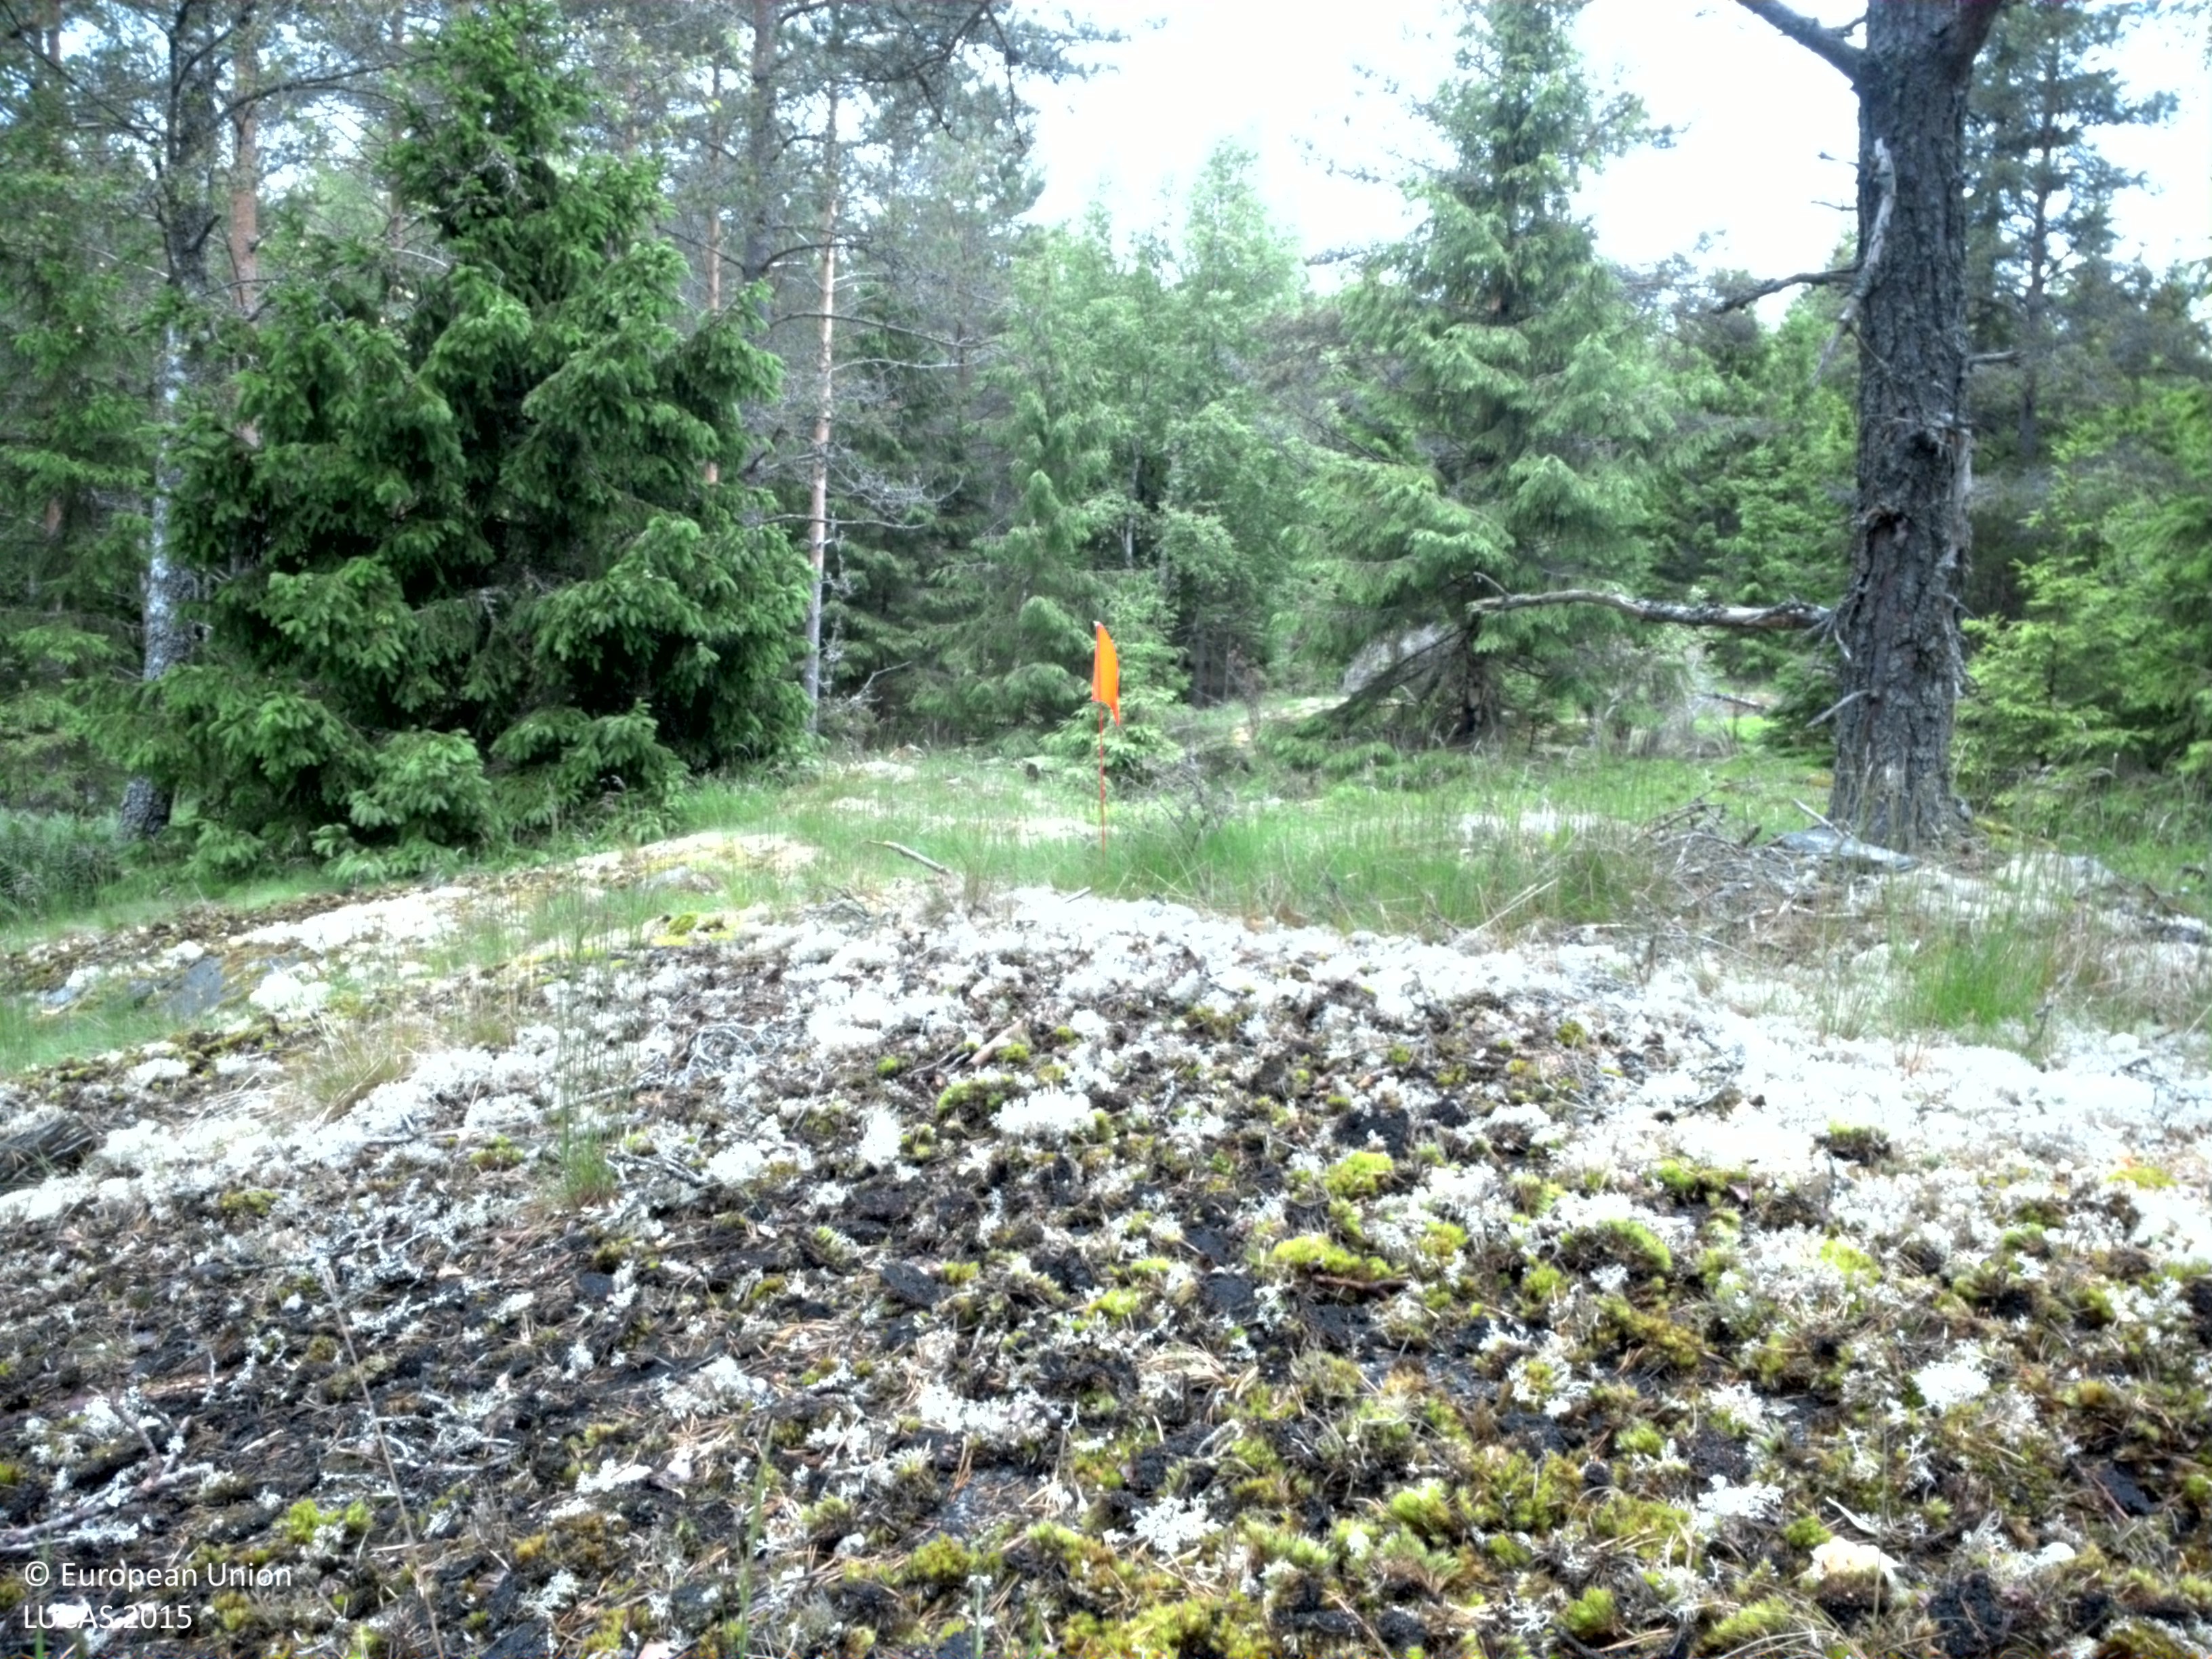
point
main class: Woodland
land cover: Pine dominated coniferous woodland
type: boreal forest
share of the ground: 10 - 25 %
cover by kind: herbaceous plants 25 %, lichens and mosses 25 %, consolidated bare surface 25 %, coniferous forest trees 20 %, broadleaved forest trees 5 %
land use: Forestry
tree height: > 5 m
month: June
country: SE
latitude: 59.6993
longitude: 18.6178
